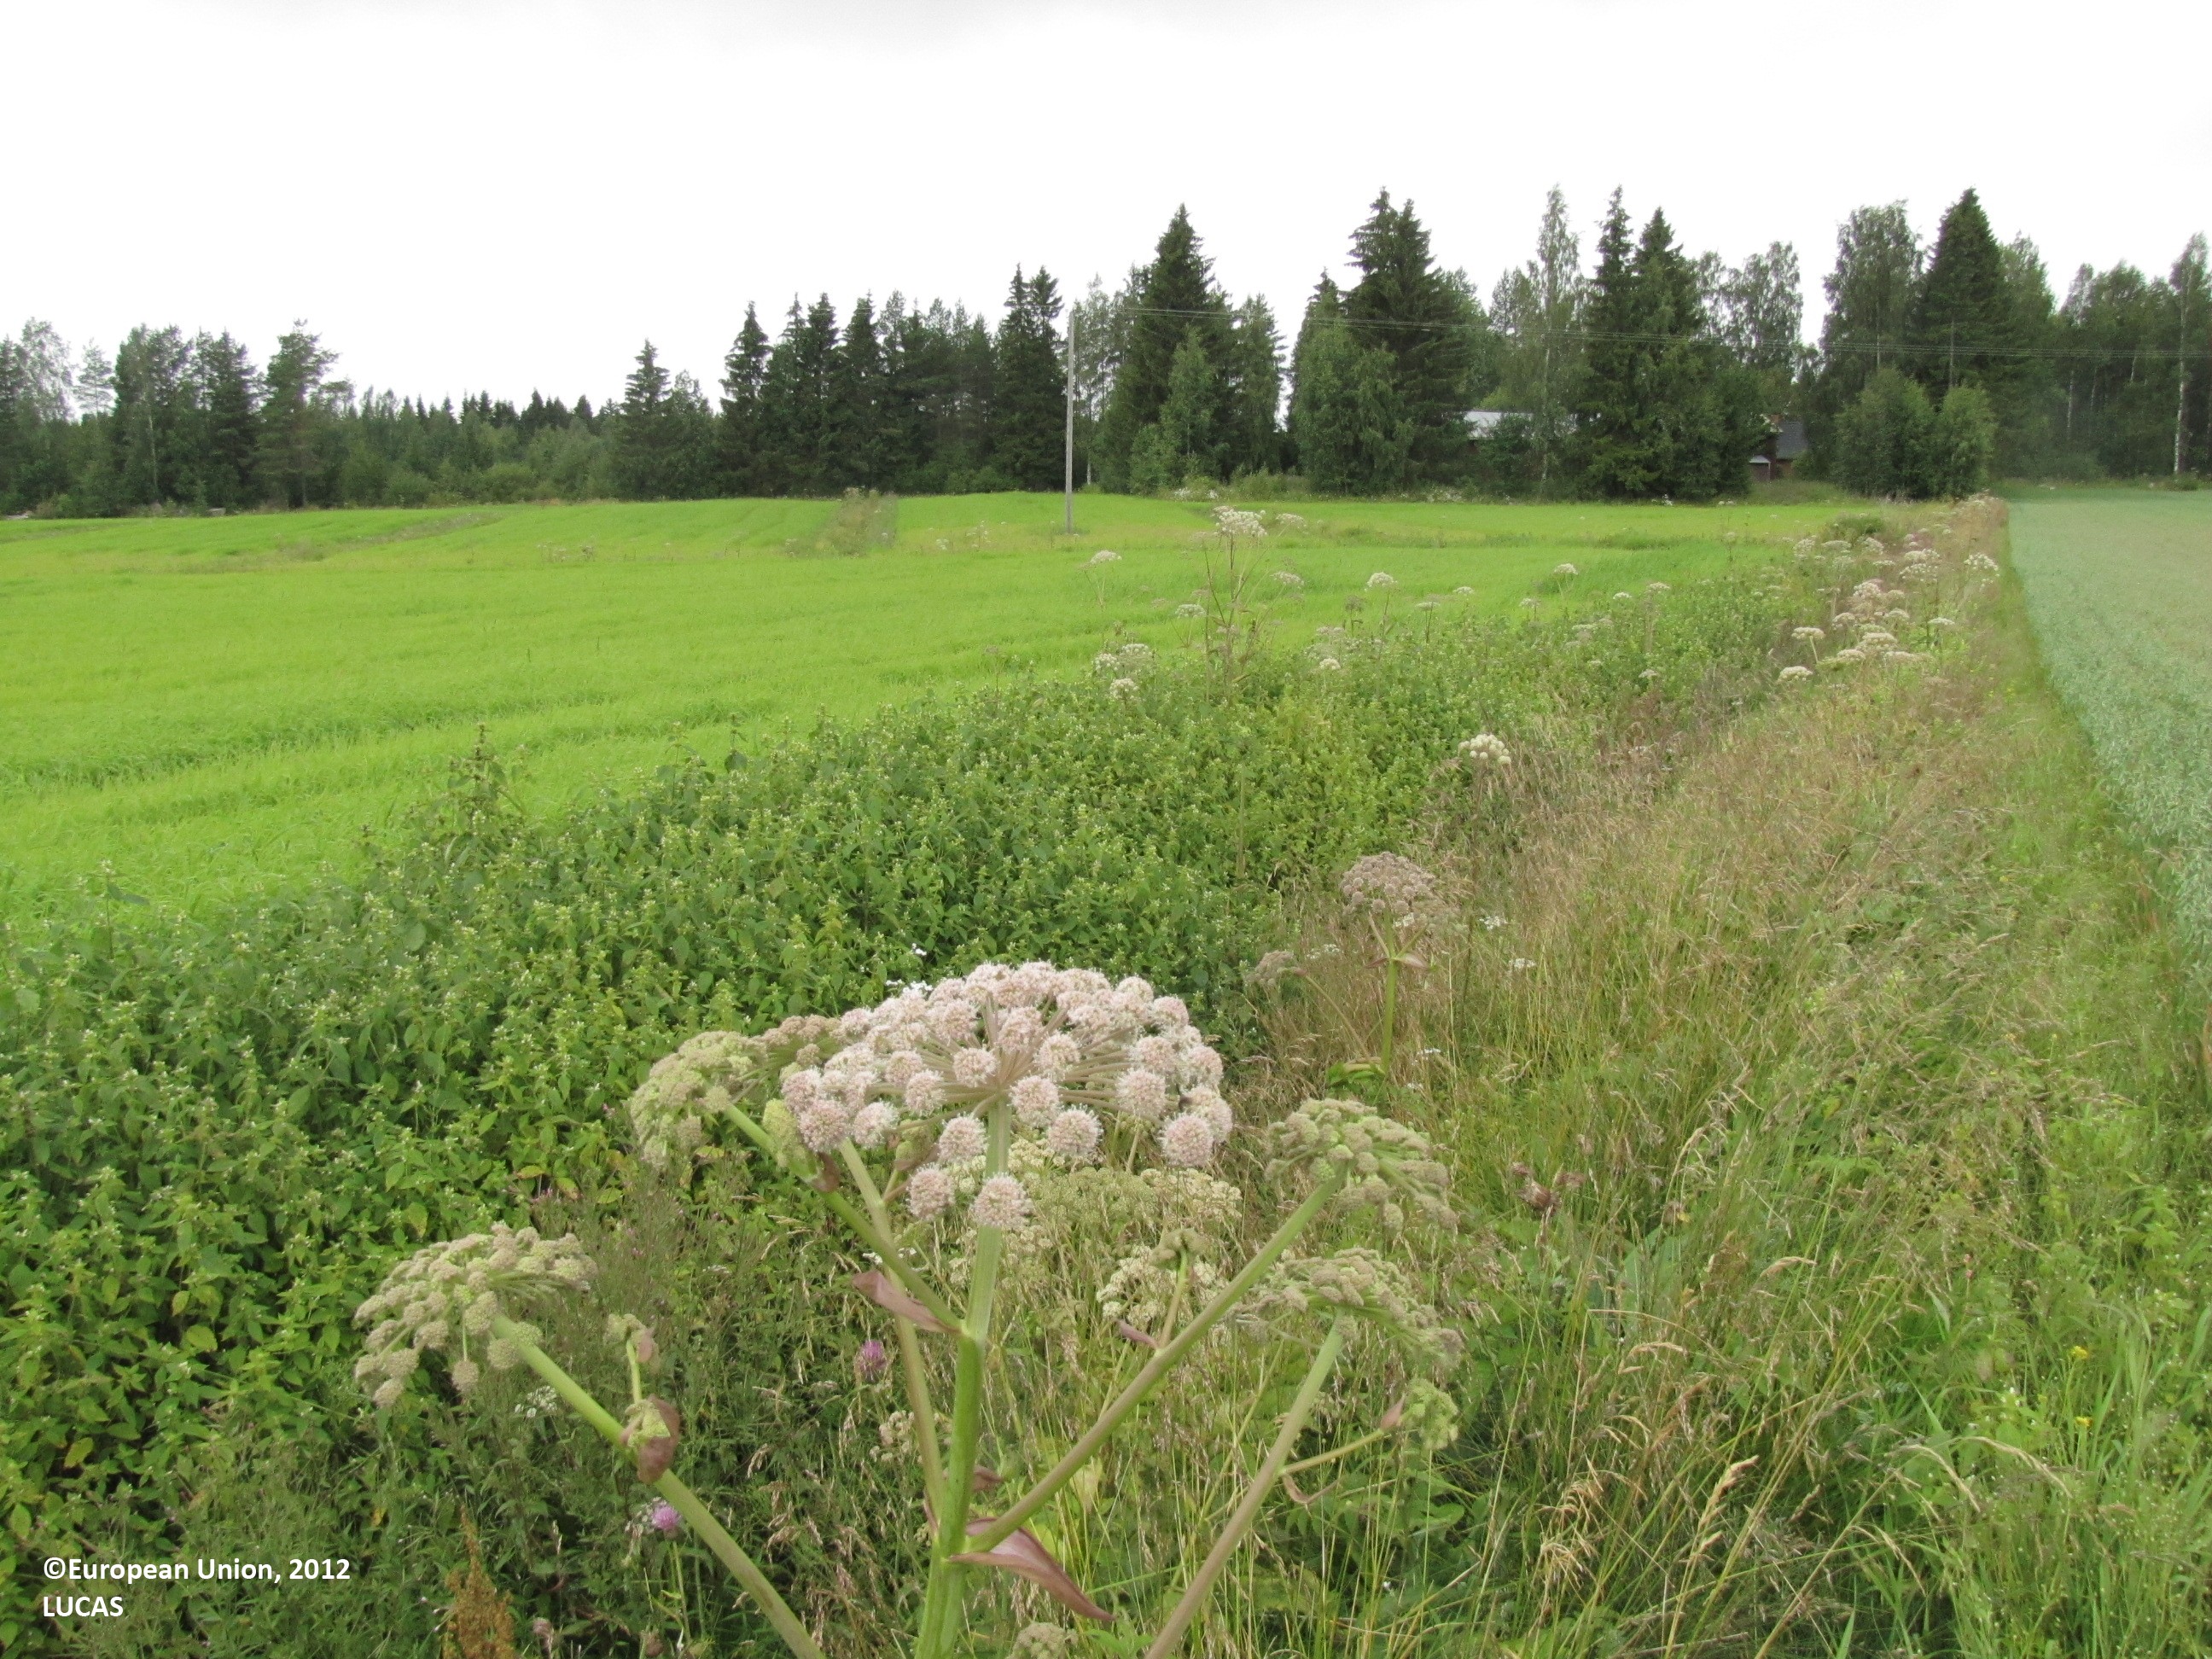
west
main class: Cropland
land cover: Oats
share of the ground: > 75 %
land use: Agriculture (excluding fallow land and kitchen gardens)
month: July
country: FI
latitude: 62.1926
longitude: 22.9973
